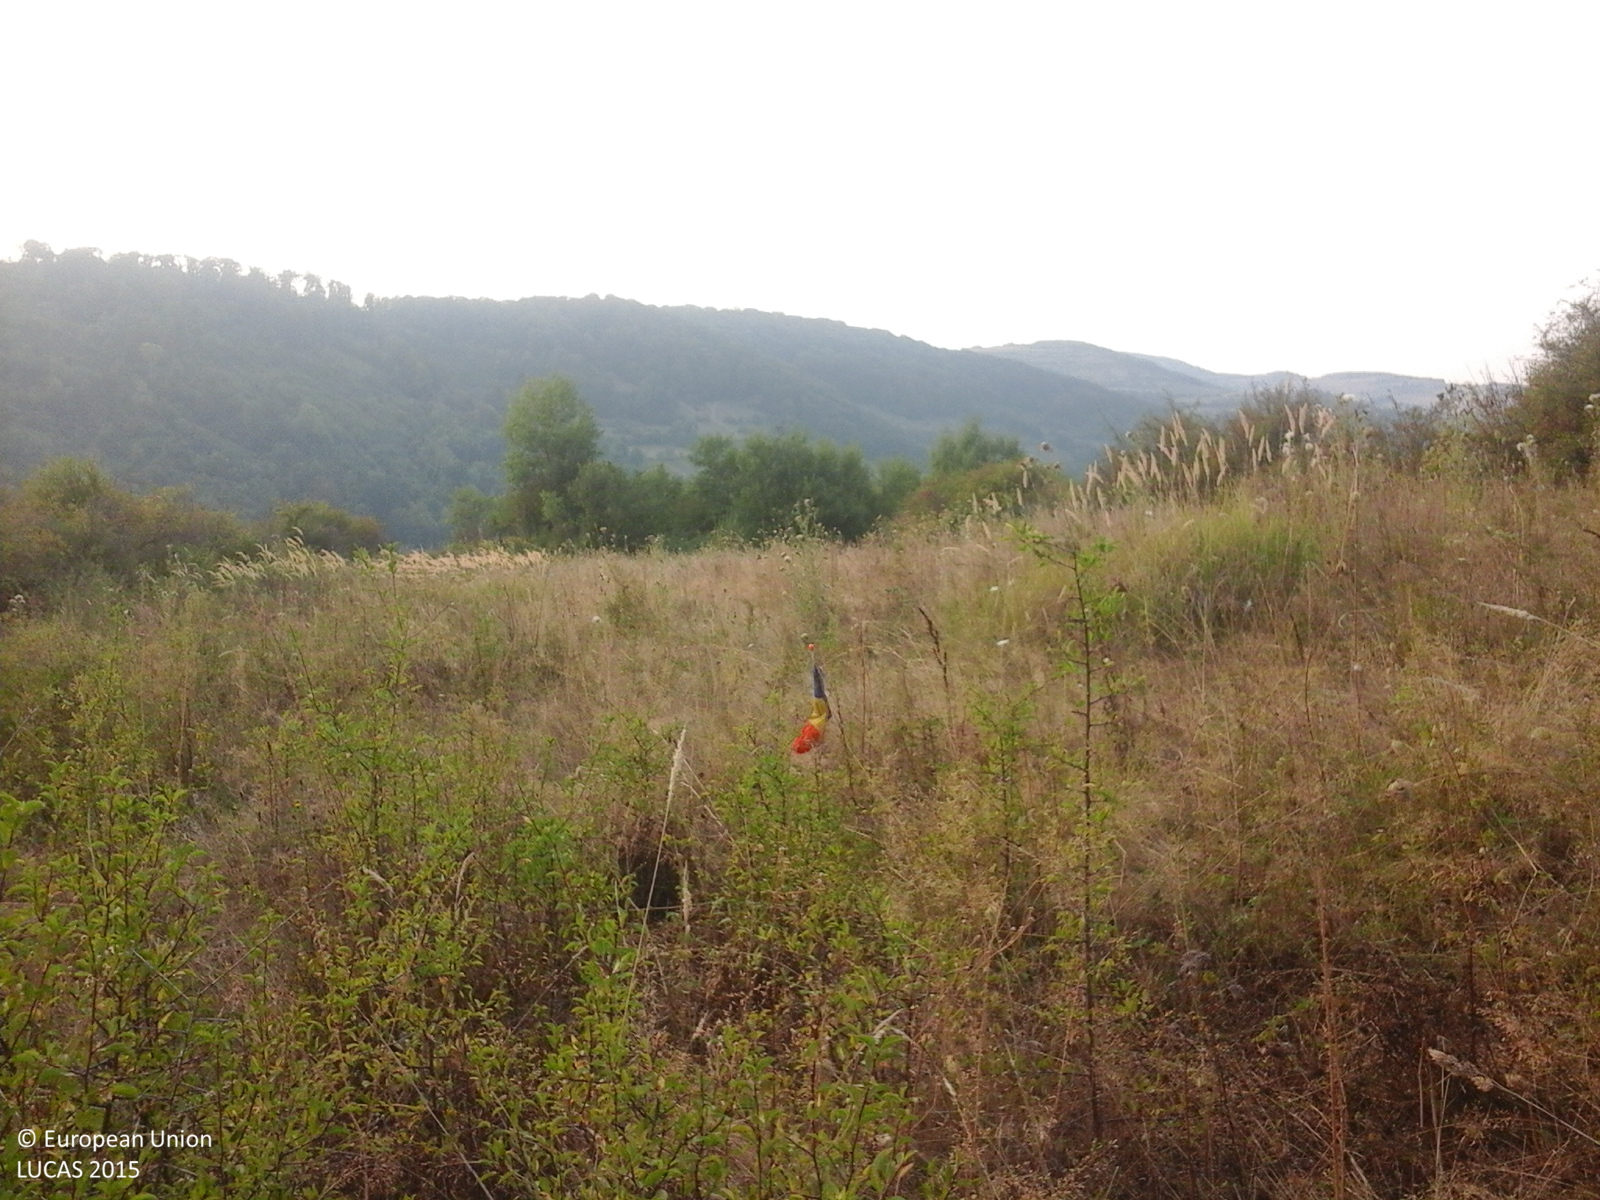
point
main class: Grassland
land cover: Spontaneously vegetated surfaces
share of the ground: > 75 %
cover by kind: herbaceous plants 100 %
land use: Fallow land
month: September
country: RO
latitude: 47.2885
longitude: 24.2750
